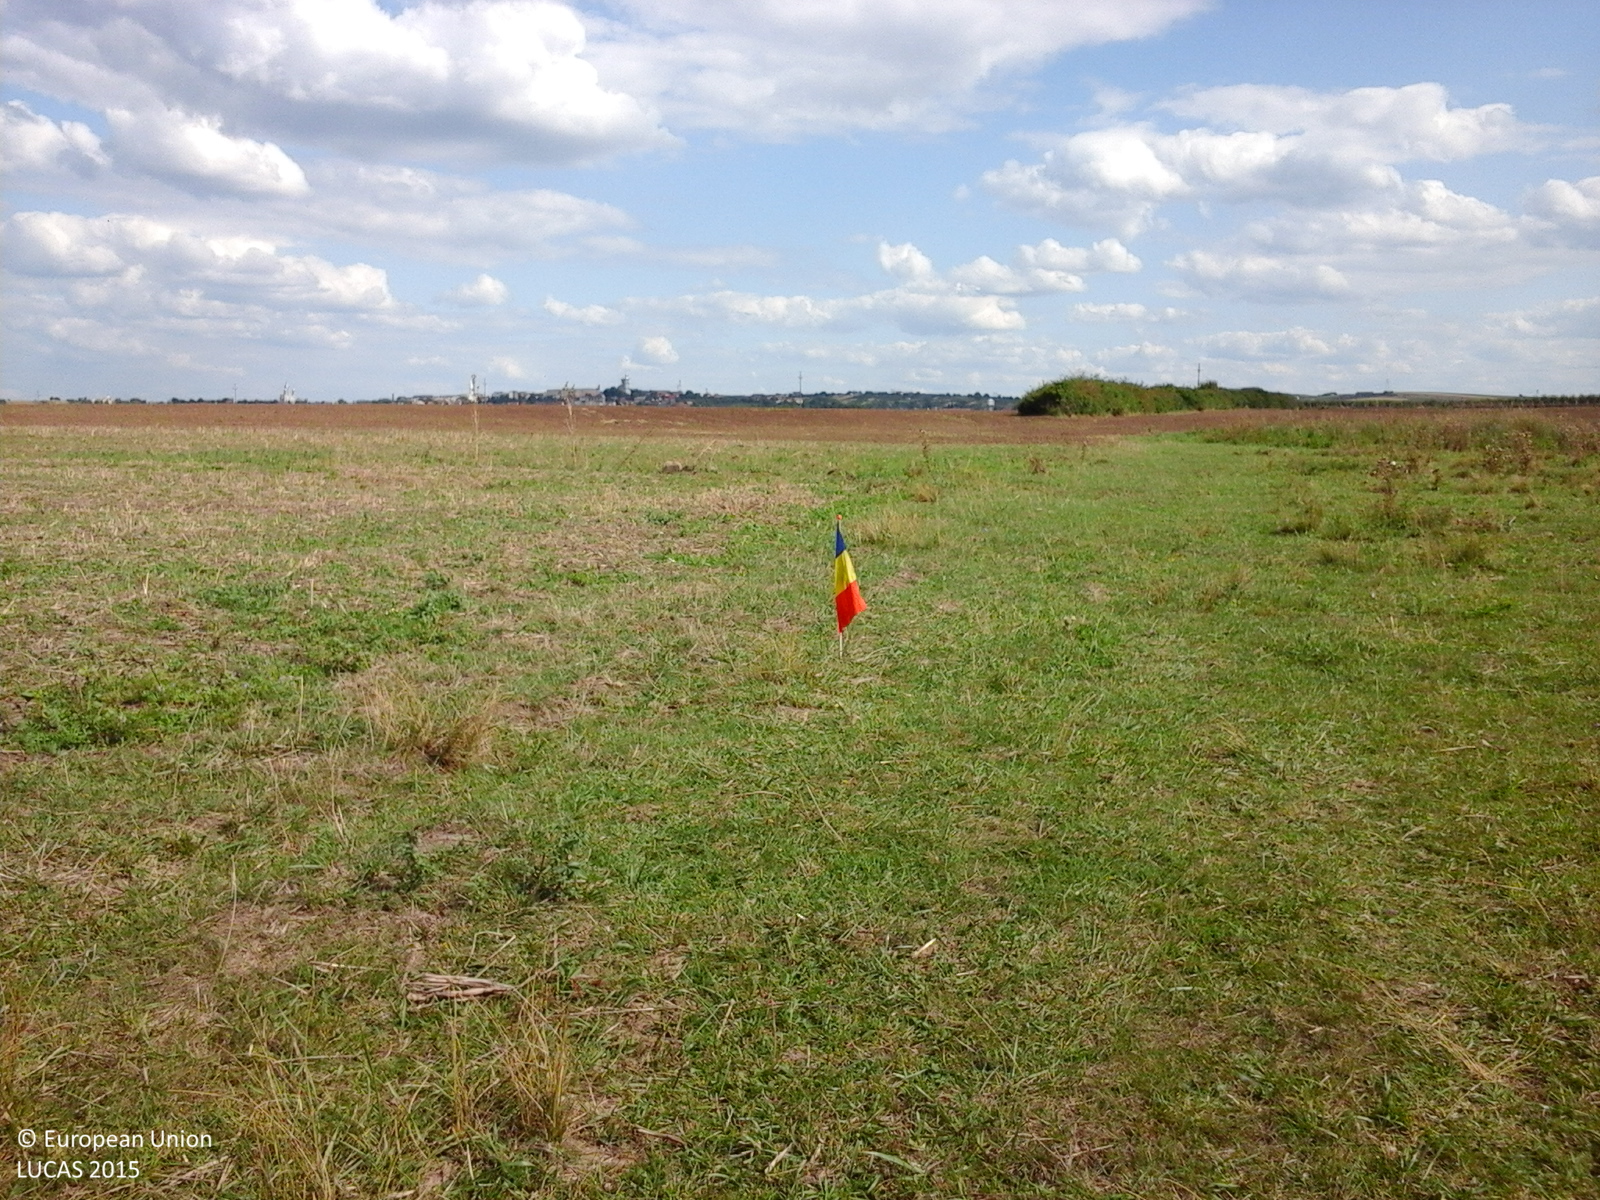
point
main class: Grassland
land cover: Grassland without tree/shrub cover
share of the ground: > 75 %
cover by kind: herbaceous plants 100 %
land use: Agriculture (excluding fallow land and kitchen gardens)
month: September
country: RO
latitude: 47.4852
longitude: 22.5461
